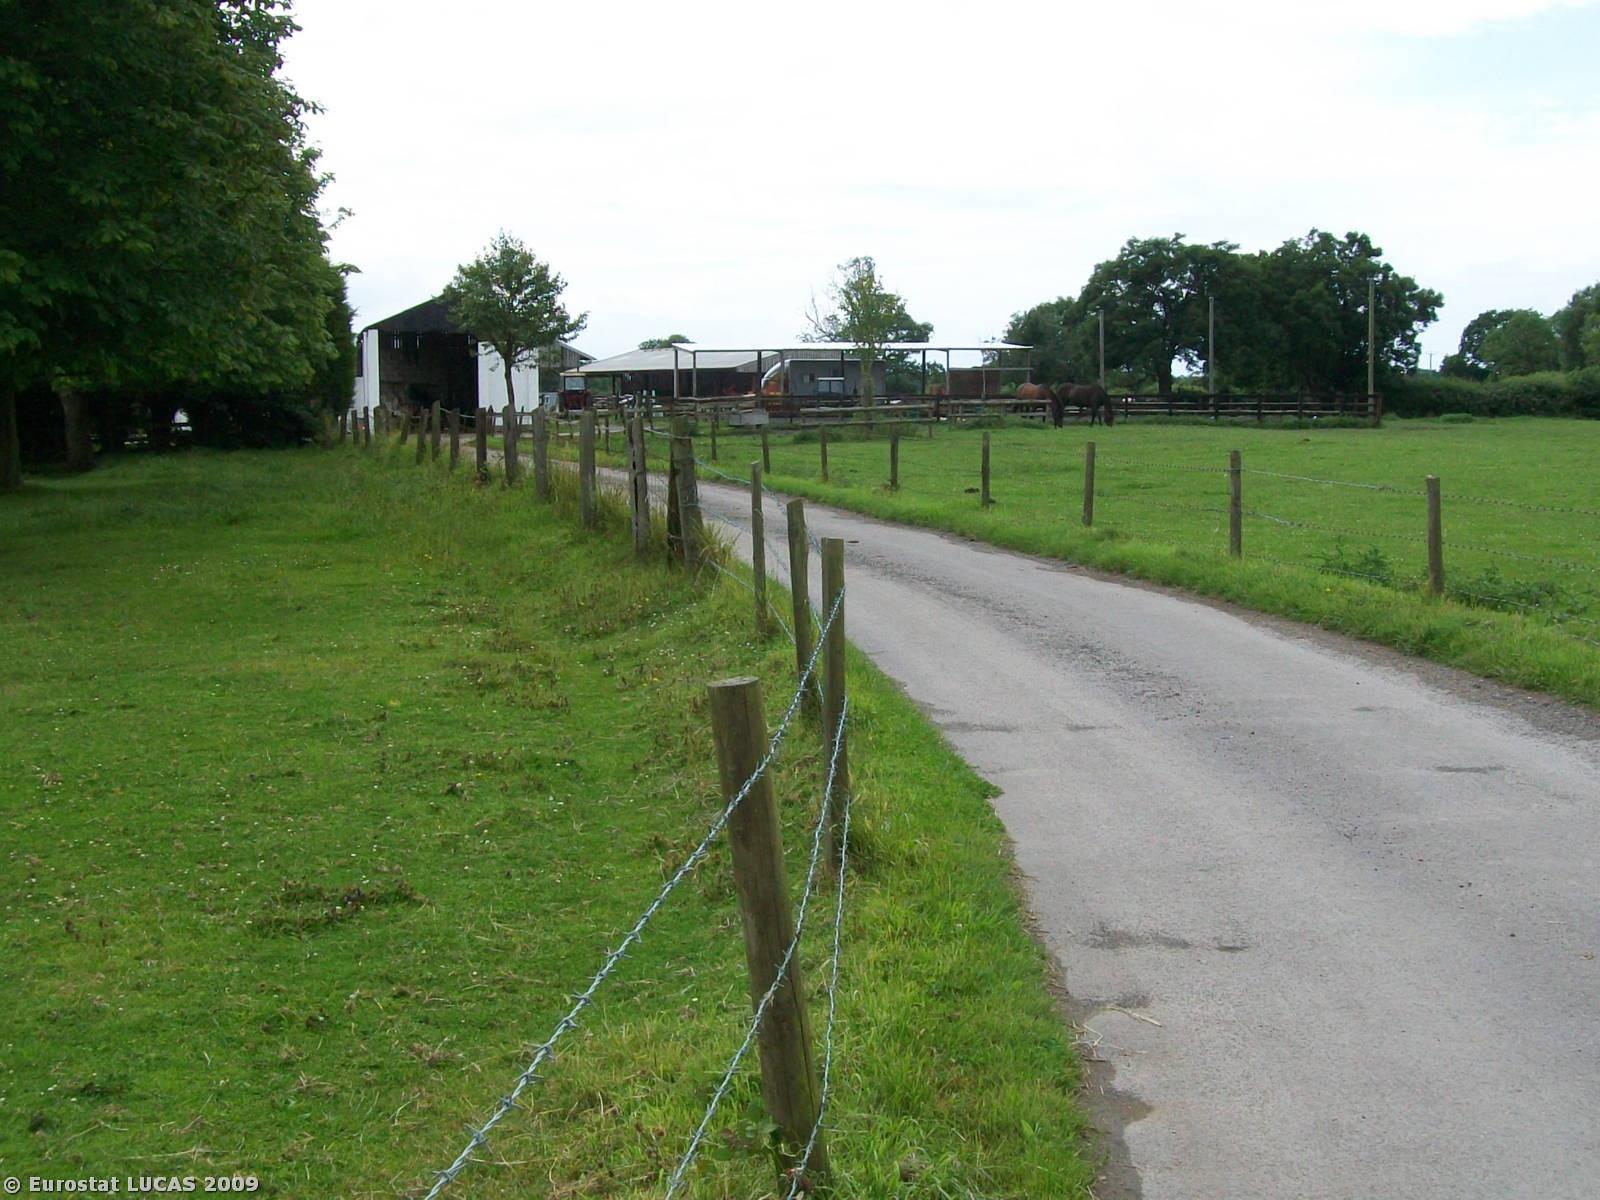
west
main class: Grassland
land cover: Grassland with sparse tree/shrub cover
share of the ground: > 75 %
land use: Agriculture (excluding fallow land and kitchen gardens)
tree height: > 5 m
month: July
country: GB
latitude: 51.4228
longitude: -2.8281
